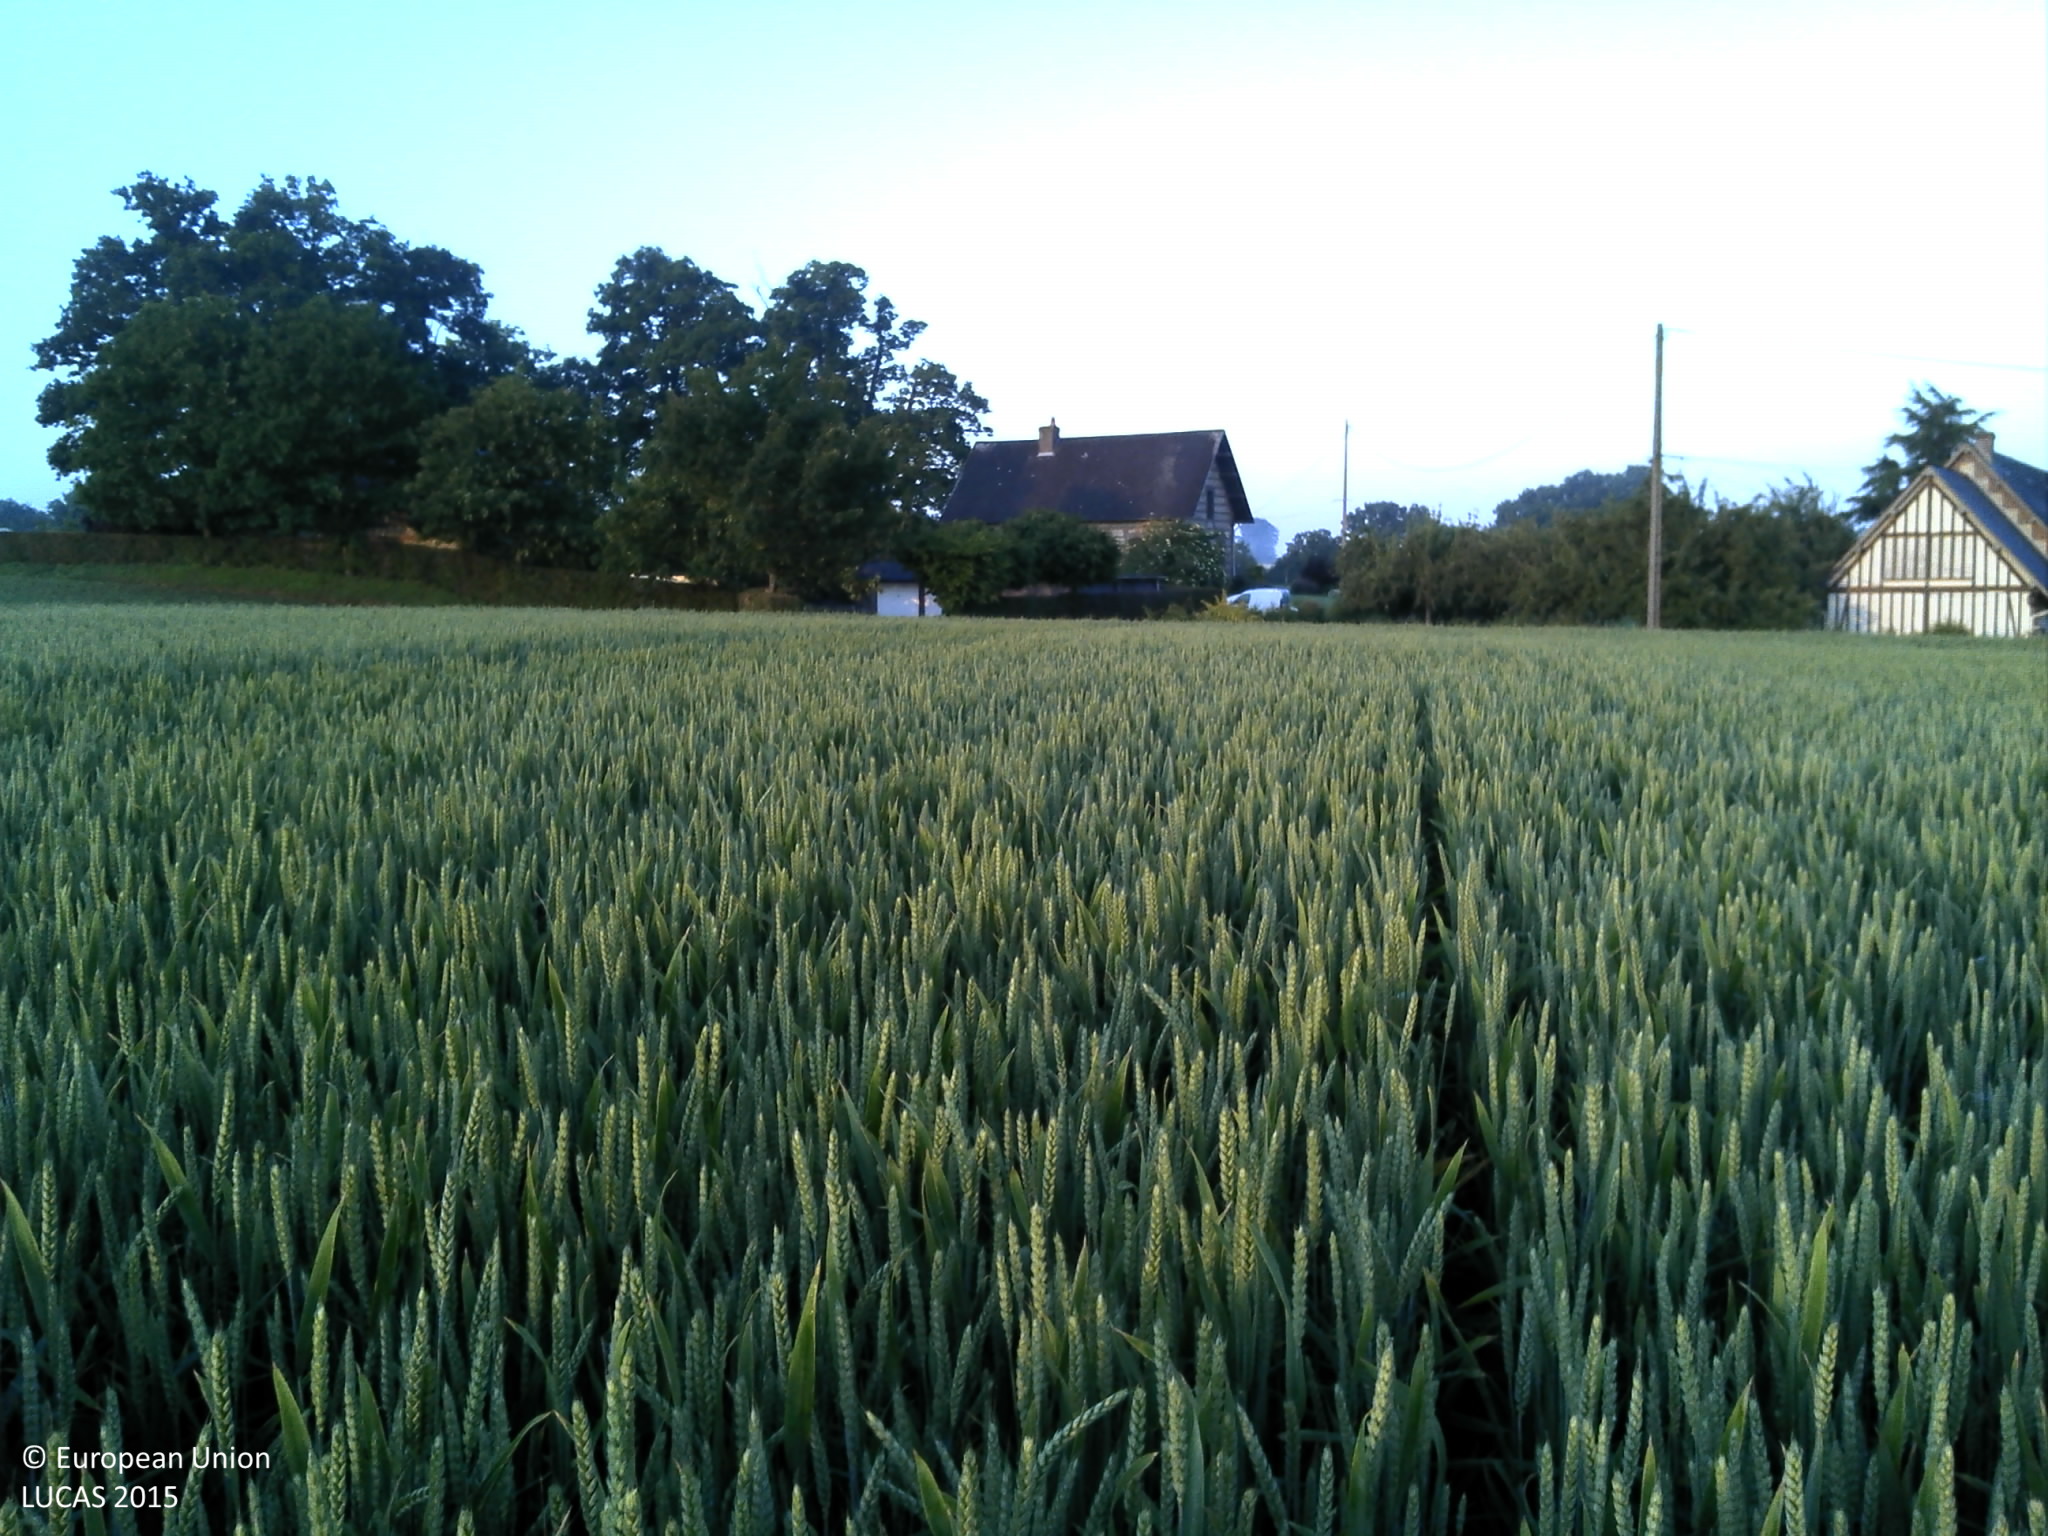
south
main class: Cropland
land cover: Common wheat
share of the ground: > 75 %
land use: Agriculture (excluding fallow land and kitchen gardens)
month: June
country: FR
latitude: 49.5330
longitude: 0.2853
